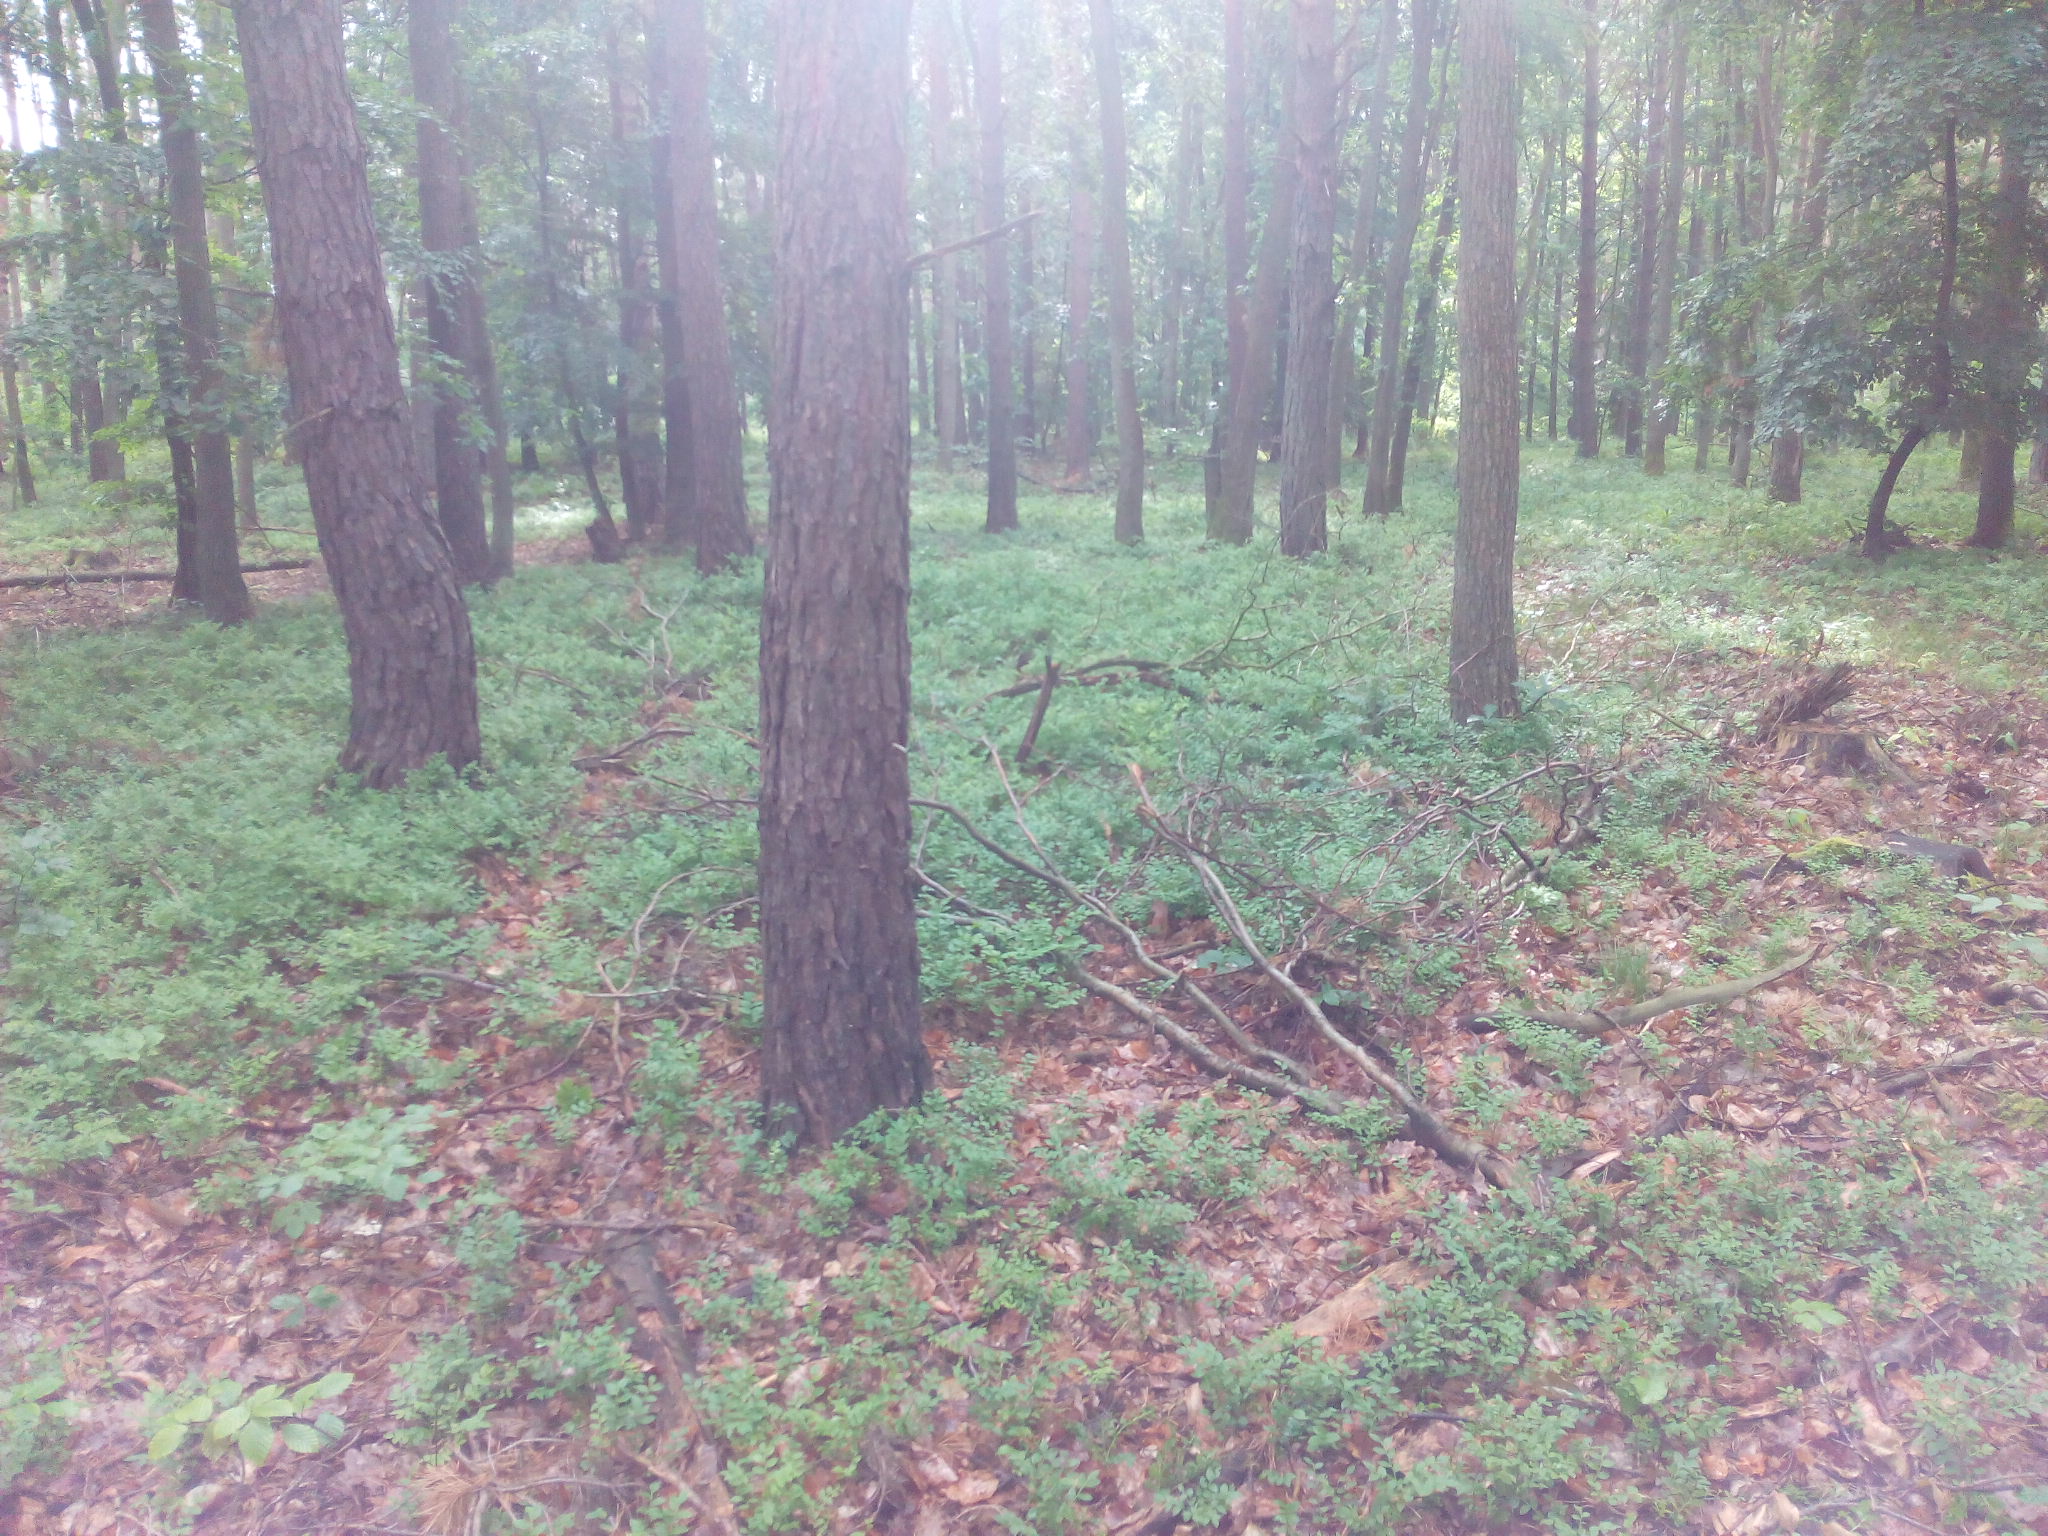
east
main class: Woodland
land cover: Other mixed woodland
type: hemiboreal forest and nemoral coniferous forest and mixed broadleaved-coniferous forest
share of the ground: 50 - 75 %
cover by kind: coniferous forest trees 40 %, broadleaved forest trees 30 %, herbaceous plants 20 %, unconsolidated bare surface 10 %
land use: Forestry
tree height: > 5 m
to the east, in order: Other mixed woodland; Pine dominated mixed woodland; Grass margins; Paved roads, cycling and walking lanes; Grass margins; Pine dominated mixed woodland; Other mixed woodland; Fences; Grassland with sparse tree/shrub cover; Broadleaved woodland; Inland fresh water bodies
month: June
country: DE
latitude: 53.3058
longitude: 13.1961
